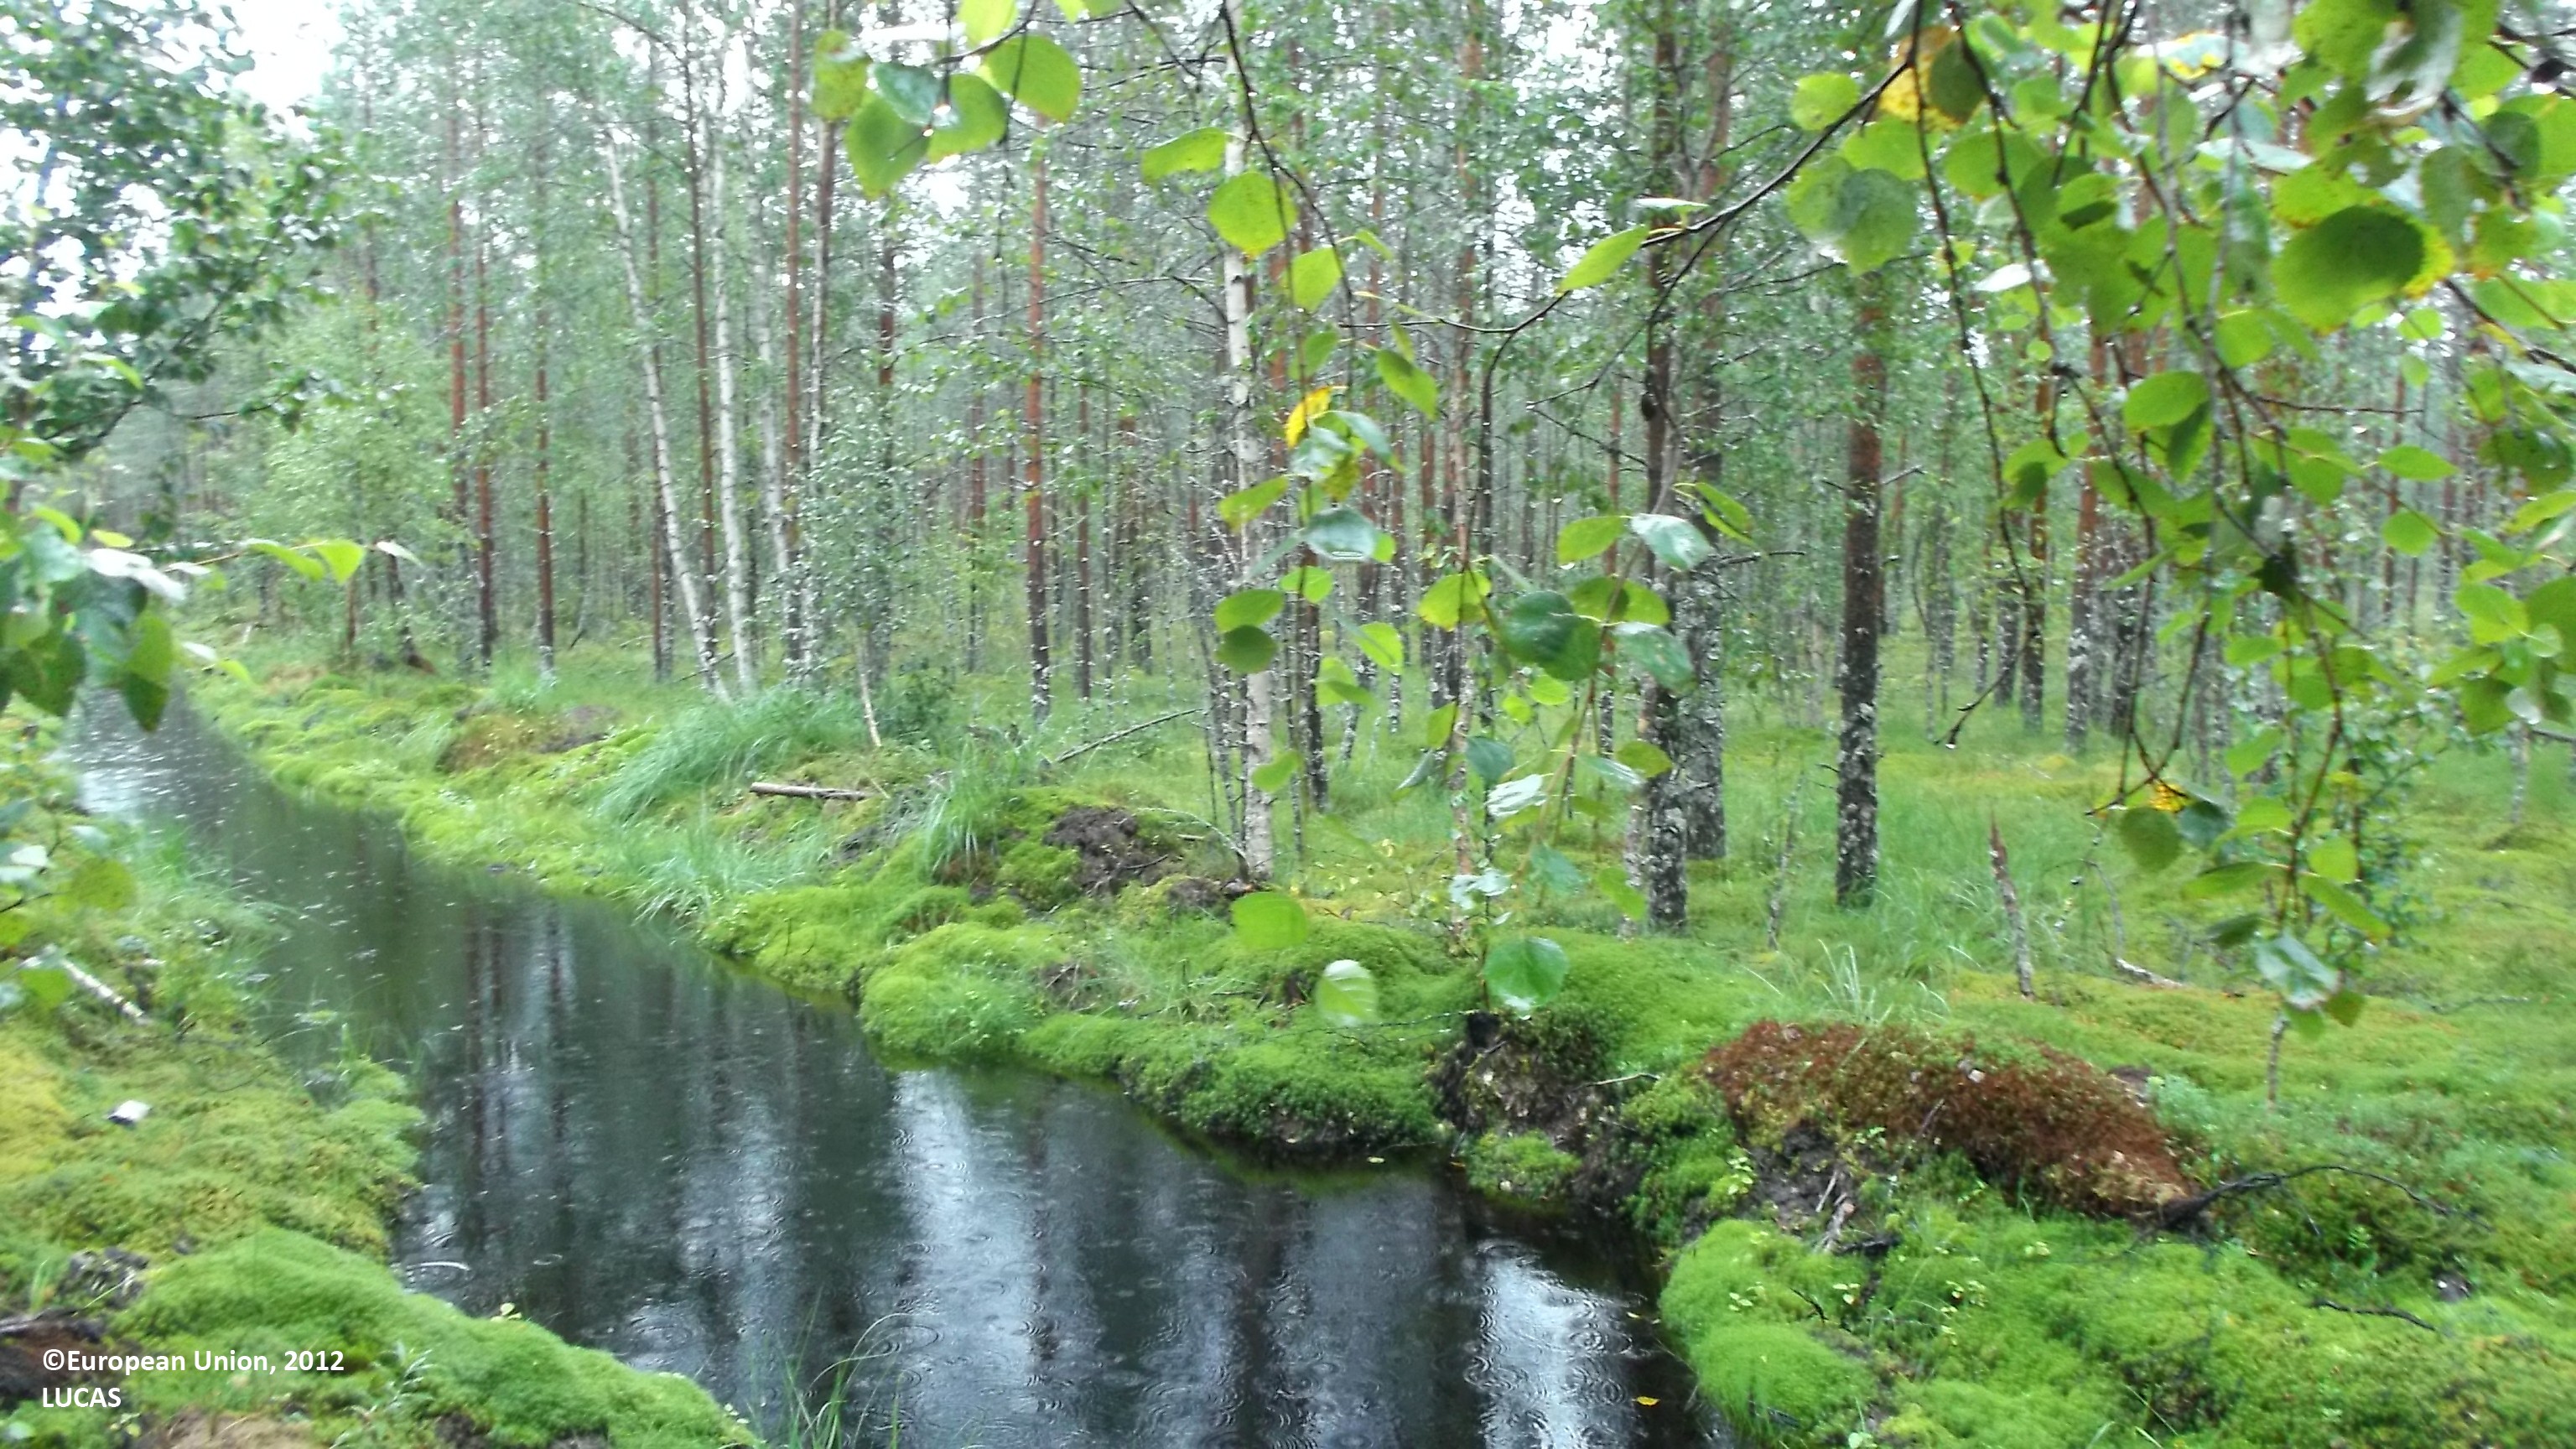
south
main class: Woodland
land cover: Other mixed woodland
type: mire and swamp forests
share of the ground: 50 - 75 %
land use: Forestry
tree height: > 5 m
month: August
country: FI
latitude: 63.3281
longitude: 24.4374
